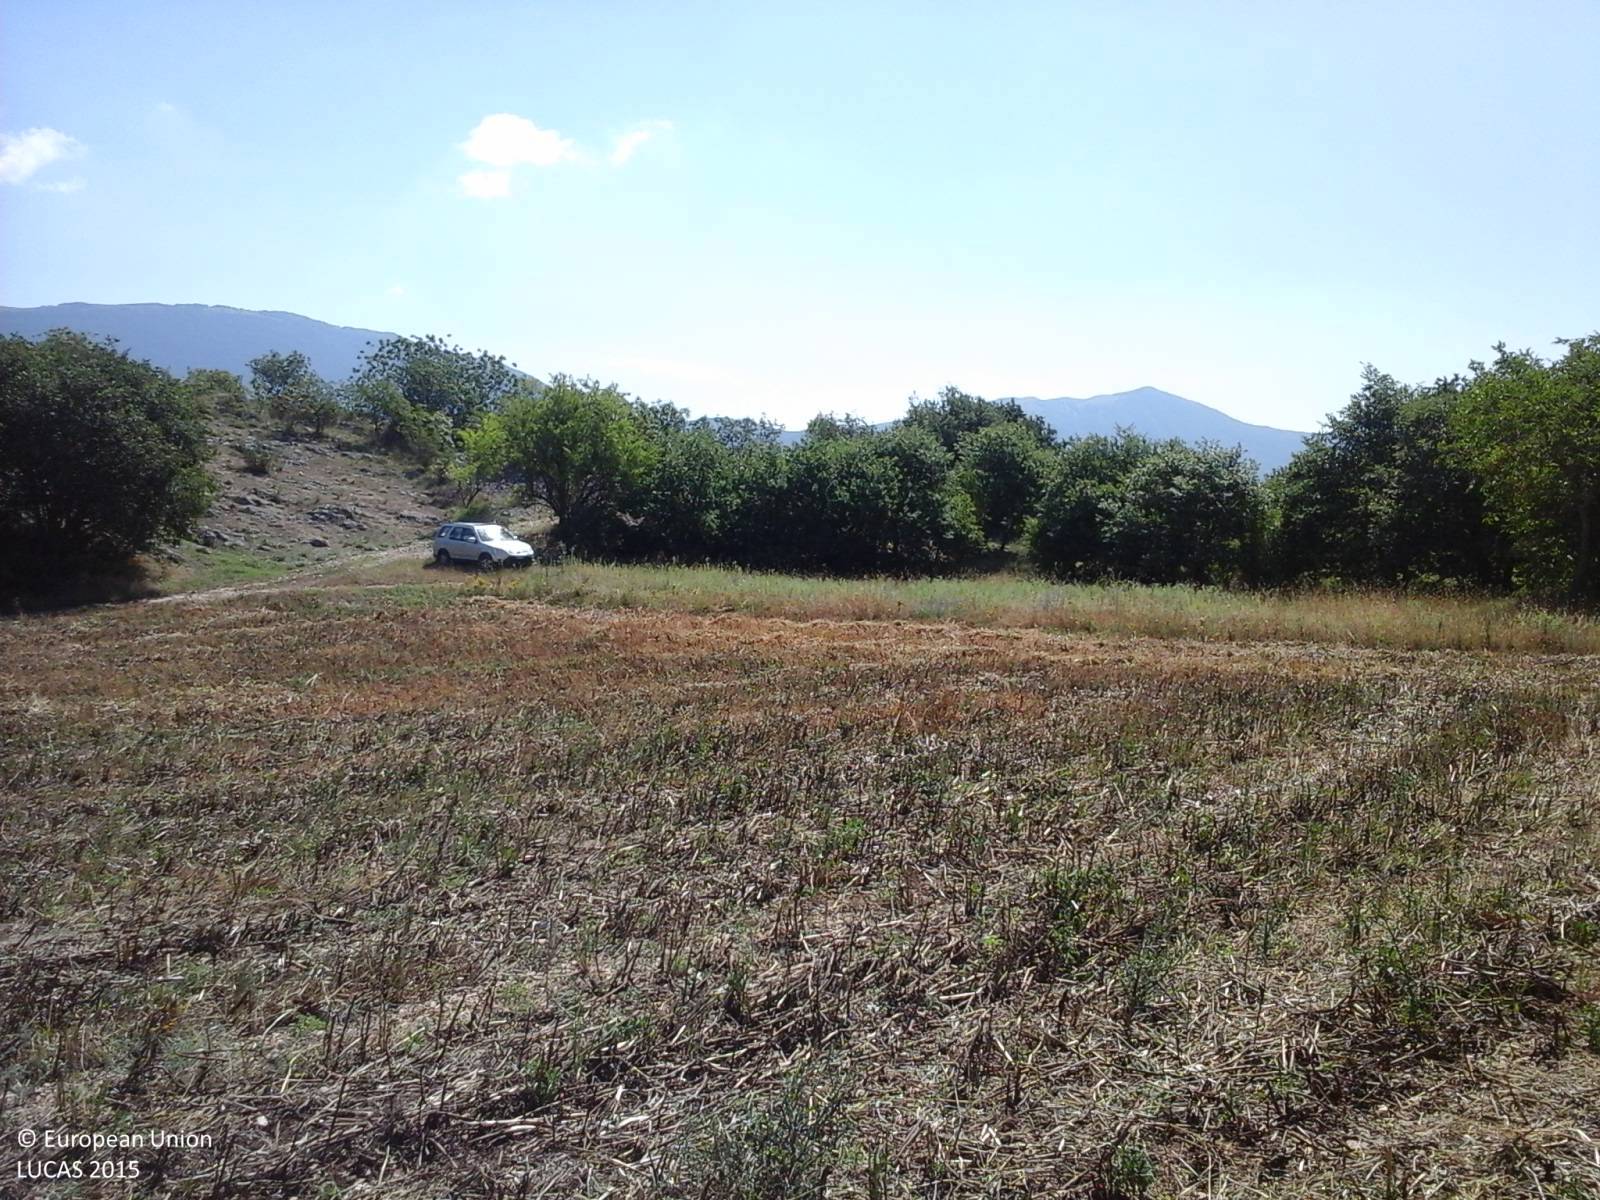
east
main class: Cropland
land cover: Lucerne
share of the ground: > 75 %
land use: Agriculture (excluding fallow land and kitchen gardens)
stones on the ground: 10 - 25 %
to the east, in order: Lucerne; Oats; Grass margins; Tracks; Grassland without tree/shrub cover; Broadleaved woodland; Rocks and stones; Tracks; Shrubland with sparse tree cover; Shrubland without tree cover; Tracks; Grassland without tree/shrub cover; Tracks; Shrubland without tree cover; Shrubland with sparse tree cover; Tracks; Single bushes/trees; Olive groves; Nuts trees
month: June
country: IT
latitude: 42.2778
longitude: 13.7349
